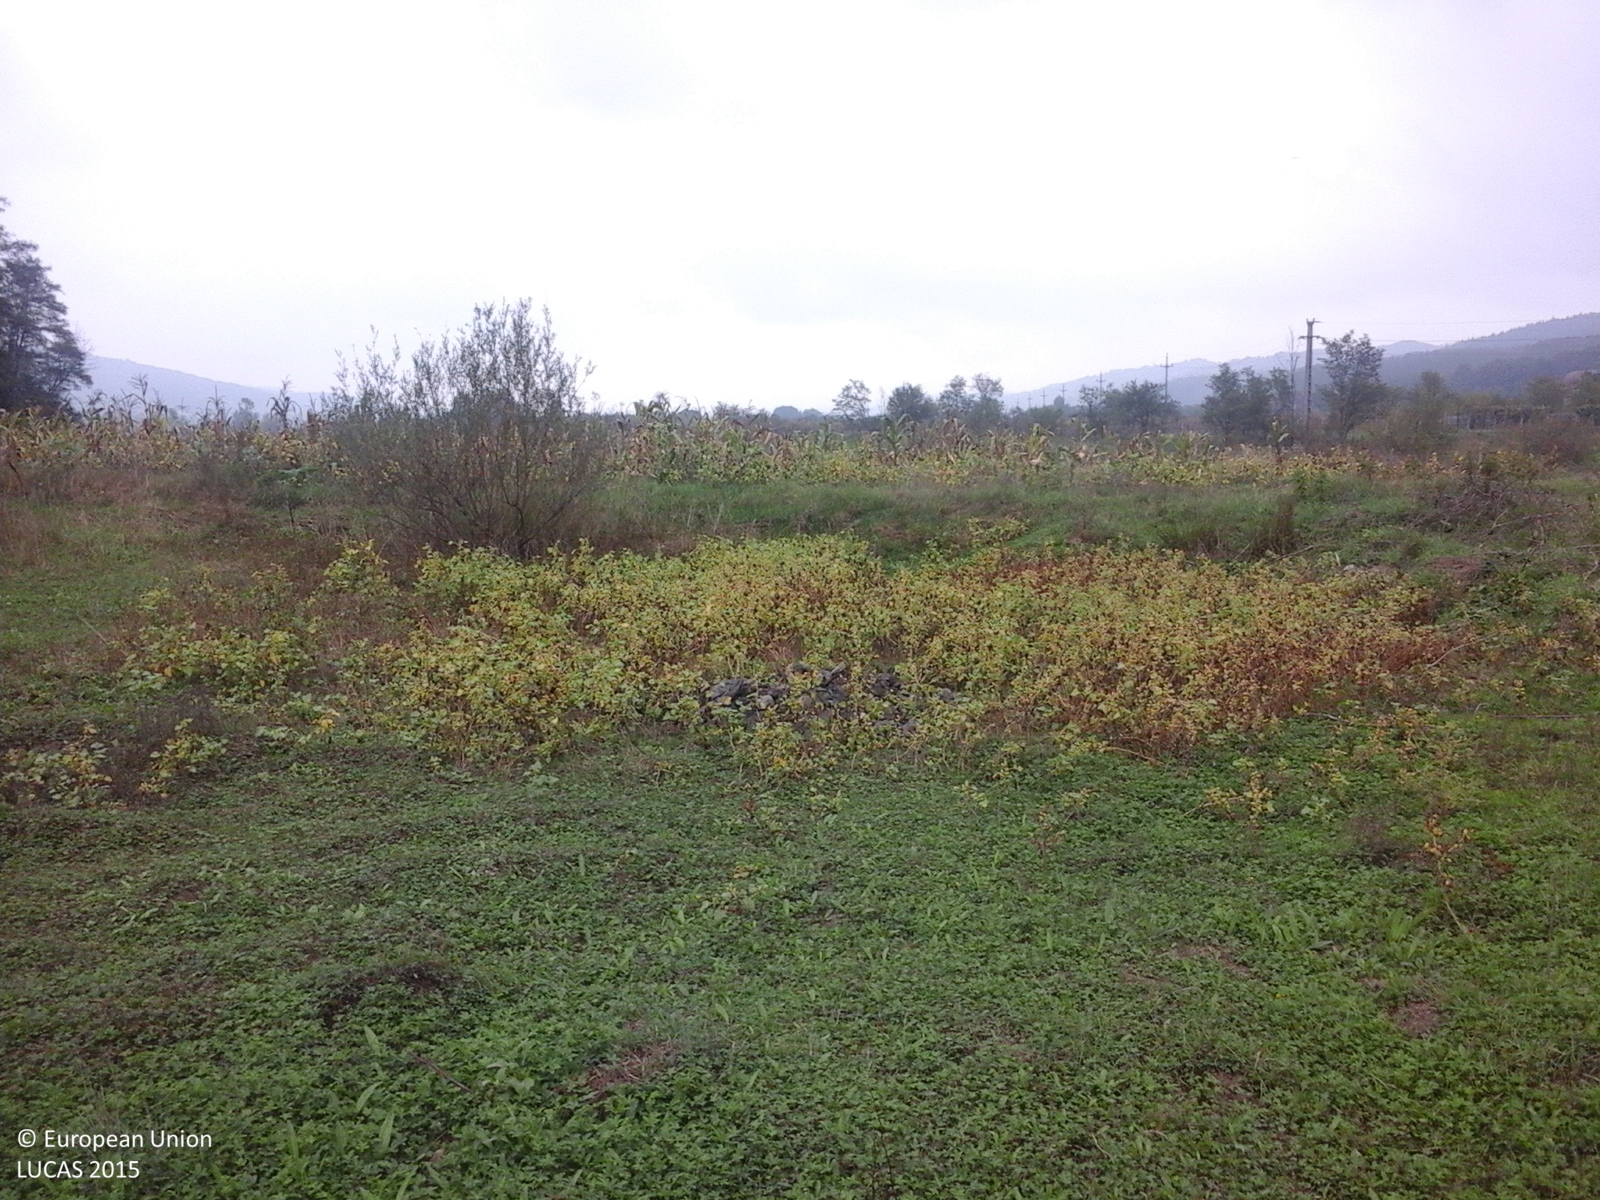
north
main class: Grassland
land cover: Spontaneously vegetated surfaces
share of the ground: > 75 %
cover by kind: herbaceous plants 100 %
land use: Fallow land
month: September
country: RO
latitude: 44.8531
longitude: 22.9156
